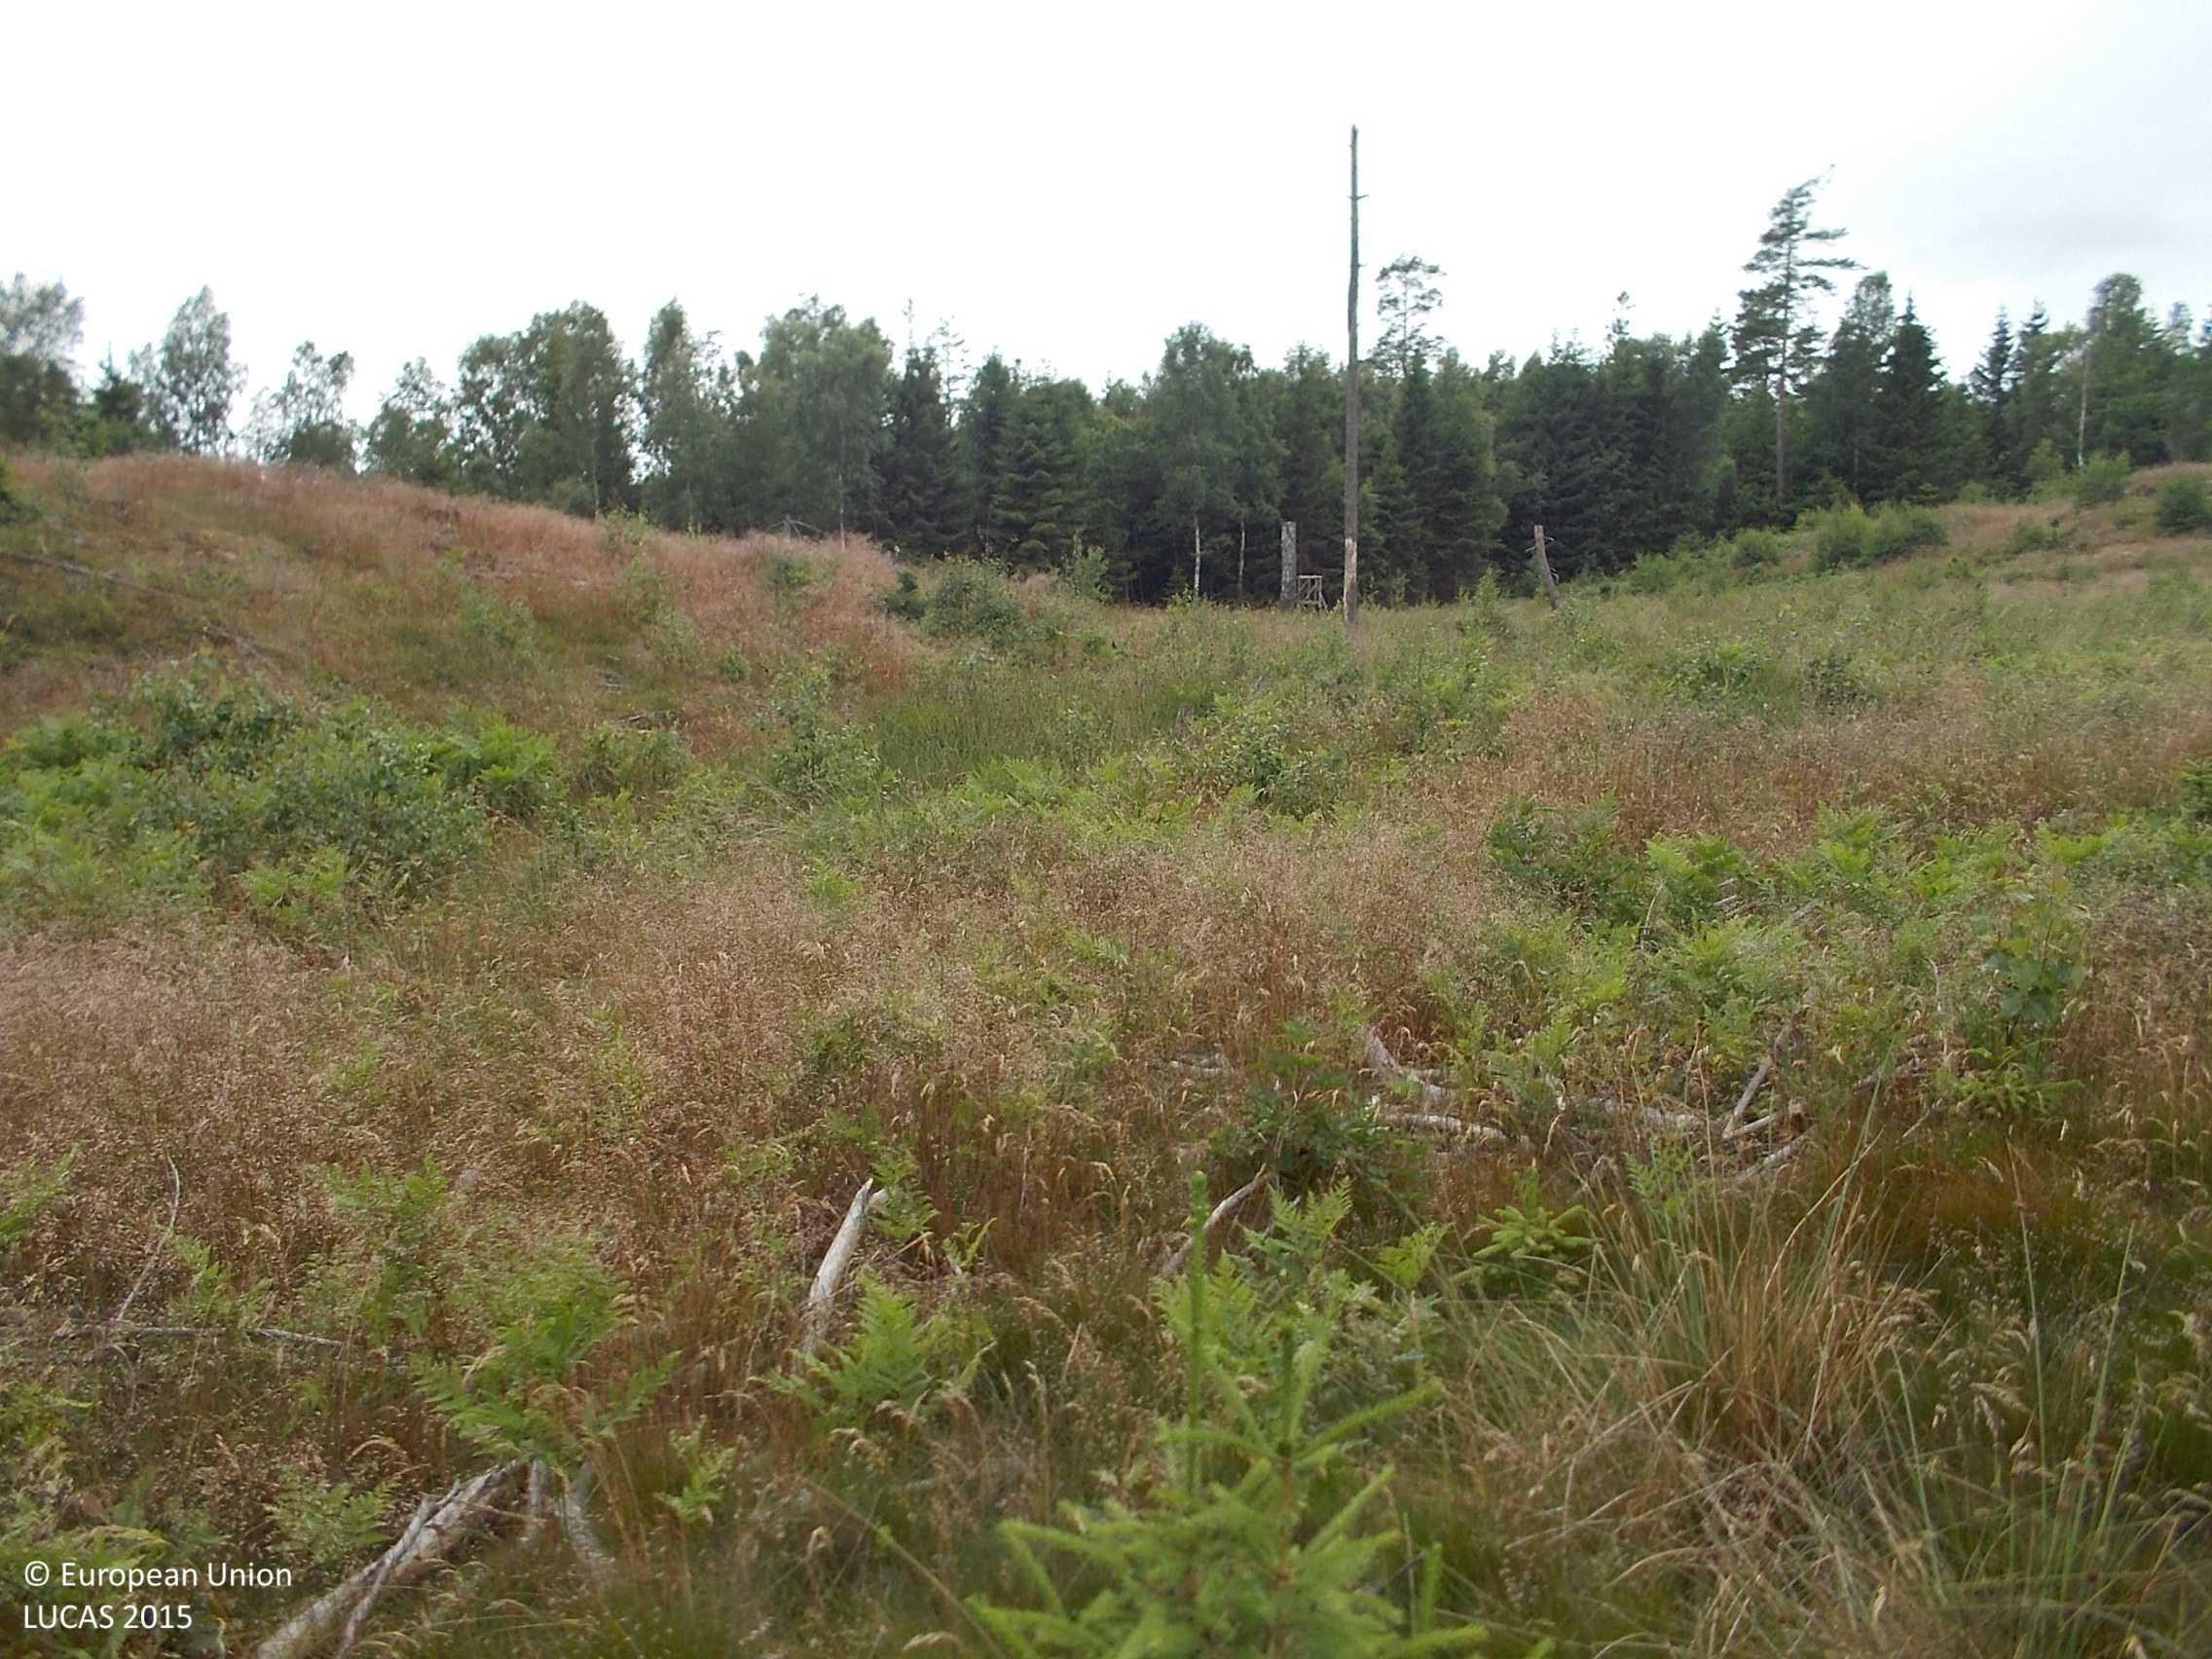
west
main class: Grassland
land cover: Grassland with sparse tree/shrub cover
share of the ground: > 75 %
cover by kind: herbaceous plants 75 %, coniferous forest trees 5 %, shrubs 5 %, lichens and mosses 5 %, unconsolidated bare surface 5 %
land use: Forestry
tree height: < 5 m
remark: Clear cut
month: July
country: SE
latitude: 57.2649
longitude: 12.2683
